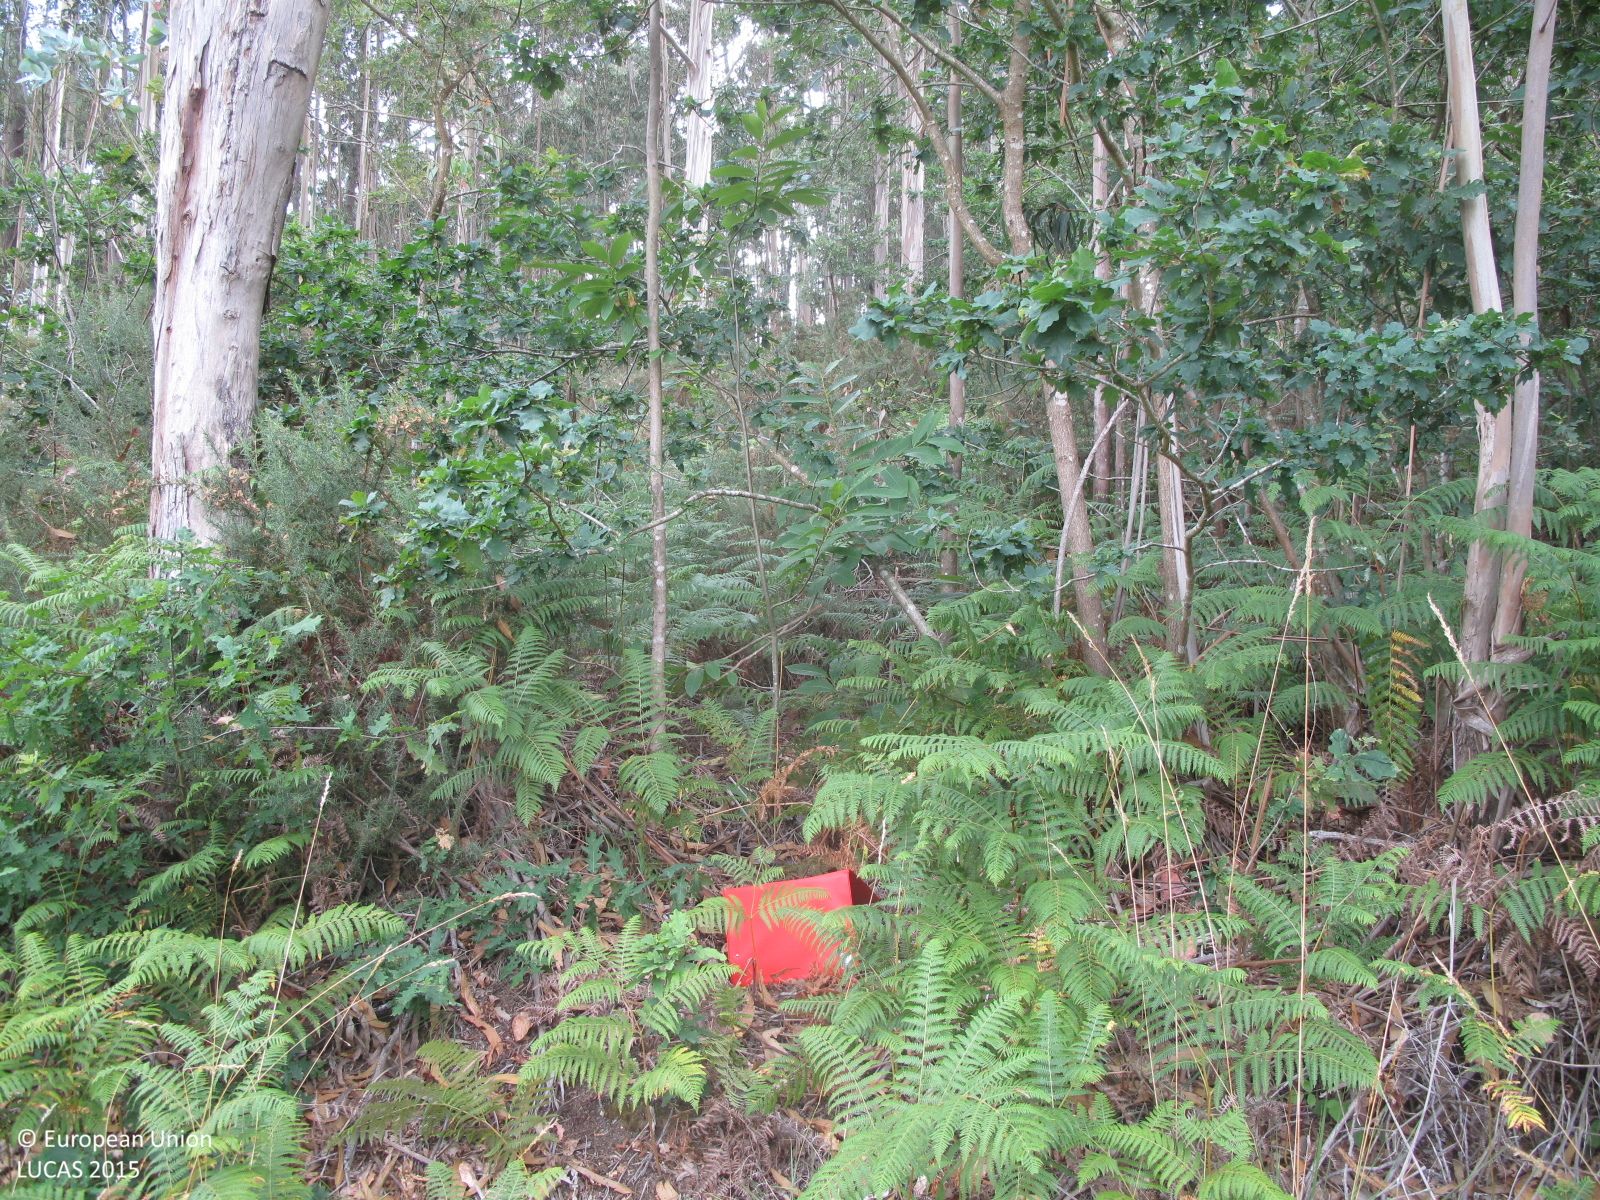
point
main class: Woodland
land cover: Broadleaved woodland
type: exotic forest
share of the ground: 50 - 75 %
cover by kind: broadleaved forest trees 60 %, shrubs 20 %, herbaceous plants 20 %
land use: Forestry
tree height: > 5 m
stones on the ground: 10 - 25 %
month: July
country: ES
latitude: 43.3257
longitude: -8.2417
